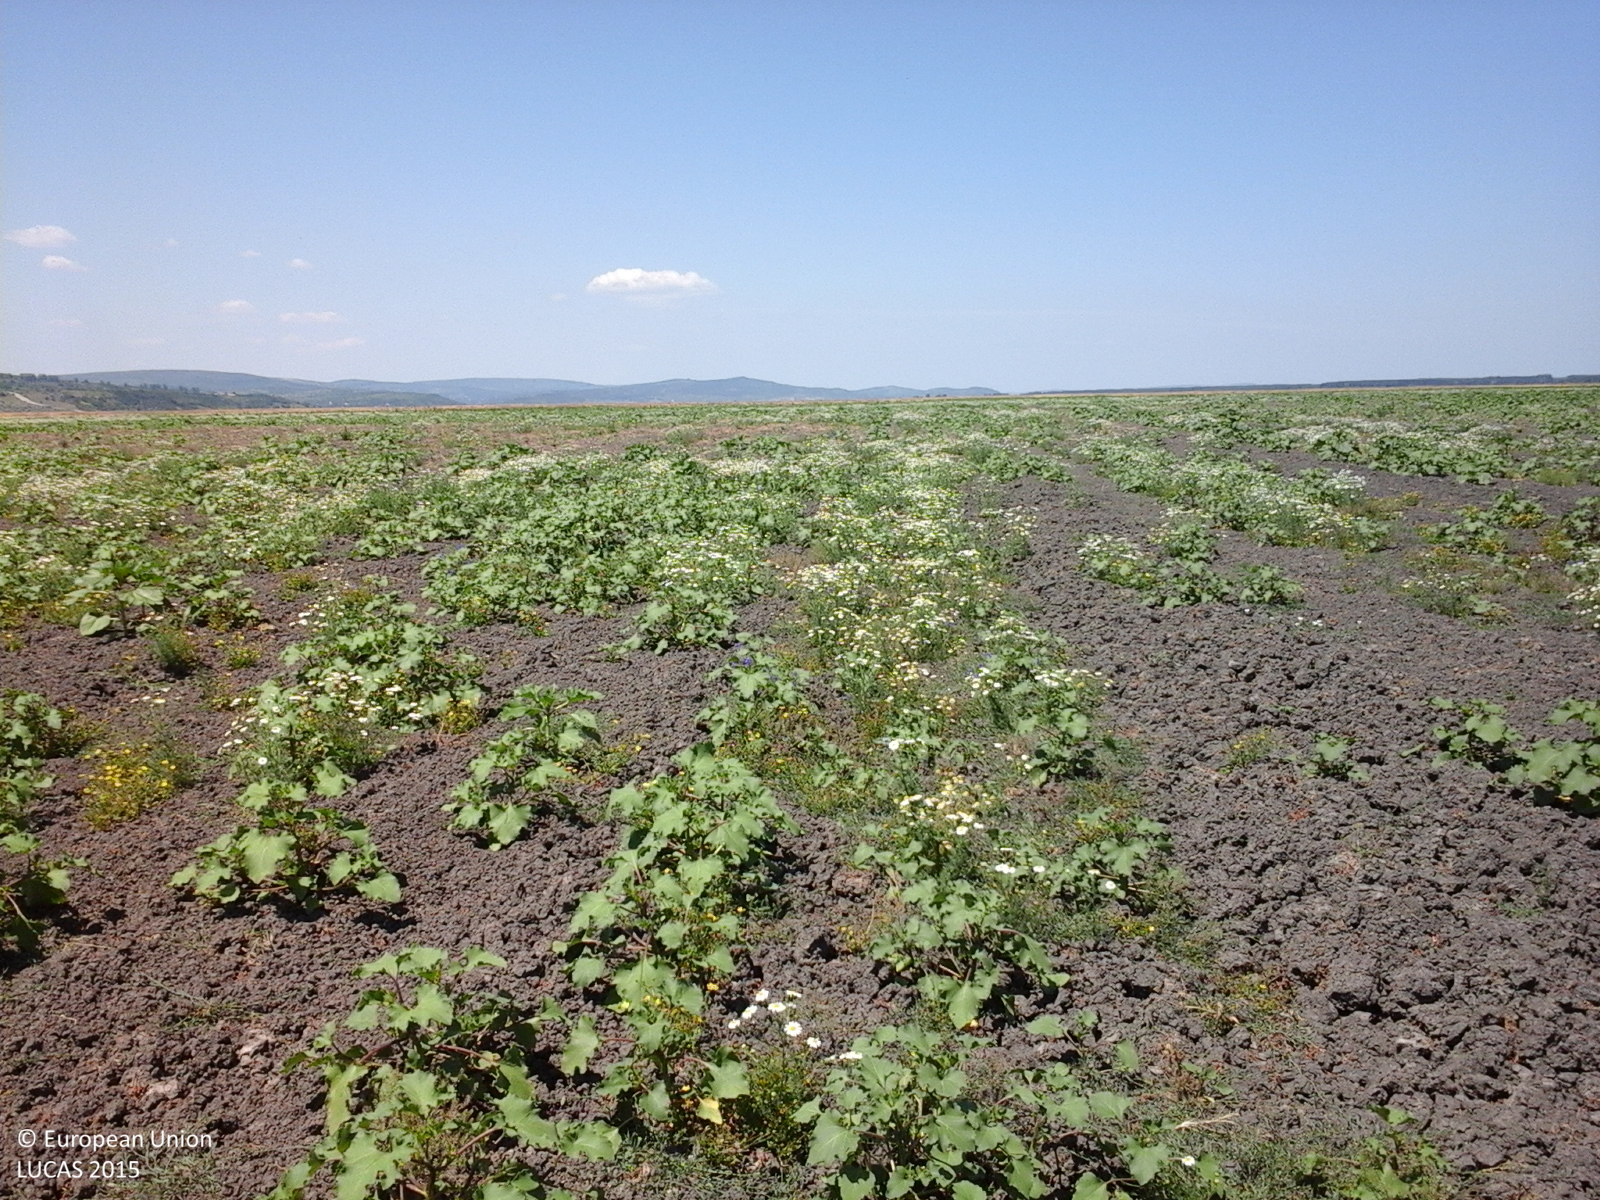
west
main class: Cropland
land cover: Other fresh vegetables
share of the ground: 50 - 75 %
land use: Agriculture (excluding fallow land and kitchen gardens)
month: June
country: RO
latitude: 47.0098
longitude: 27.9520
